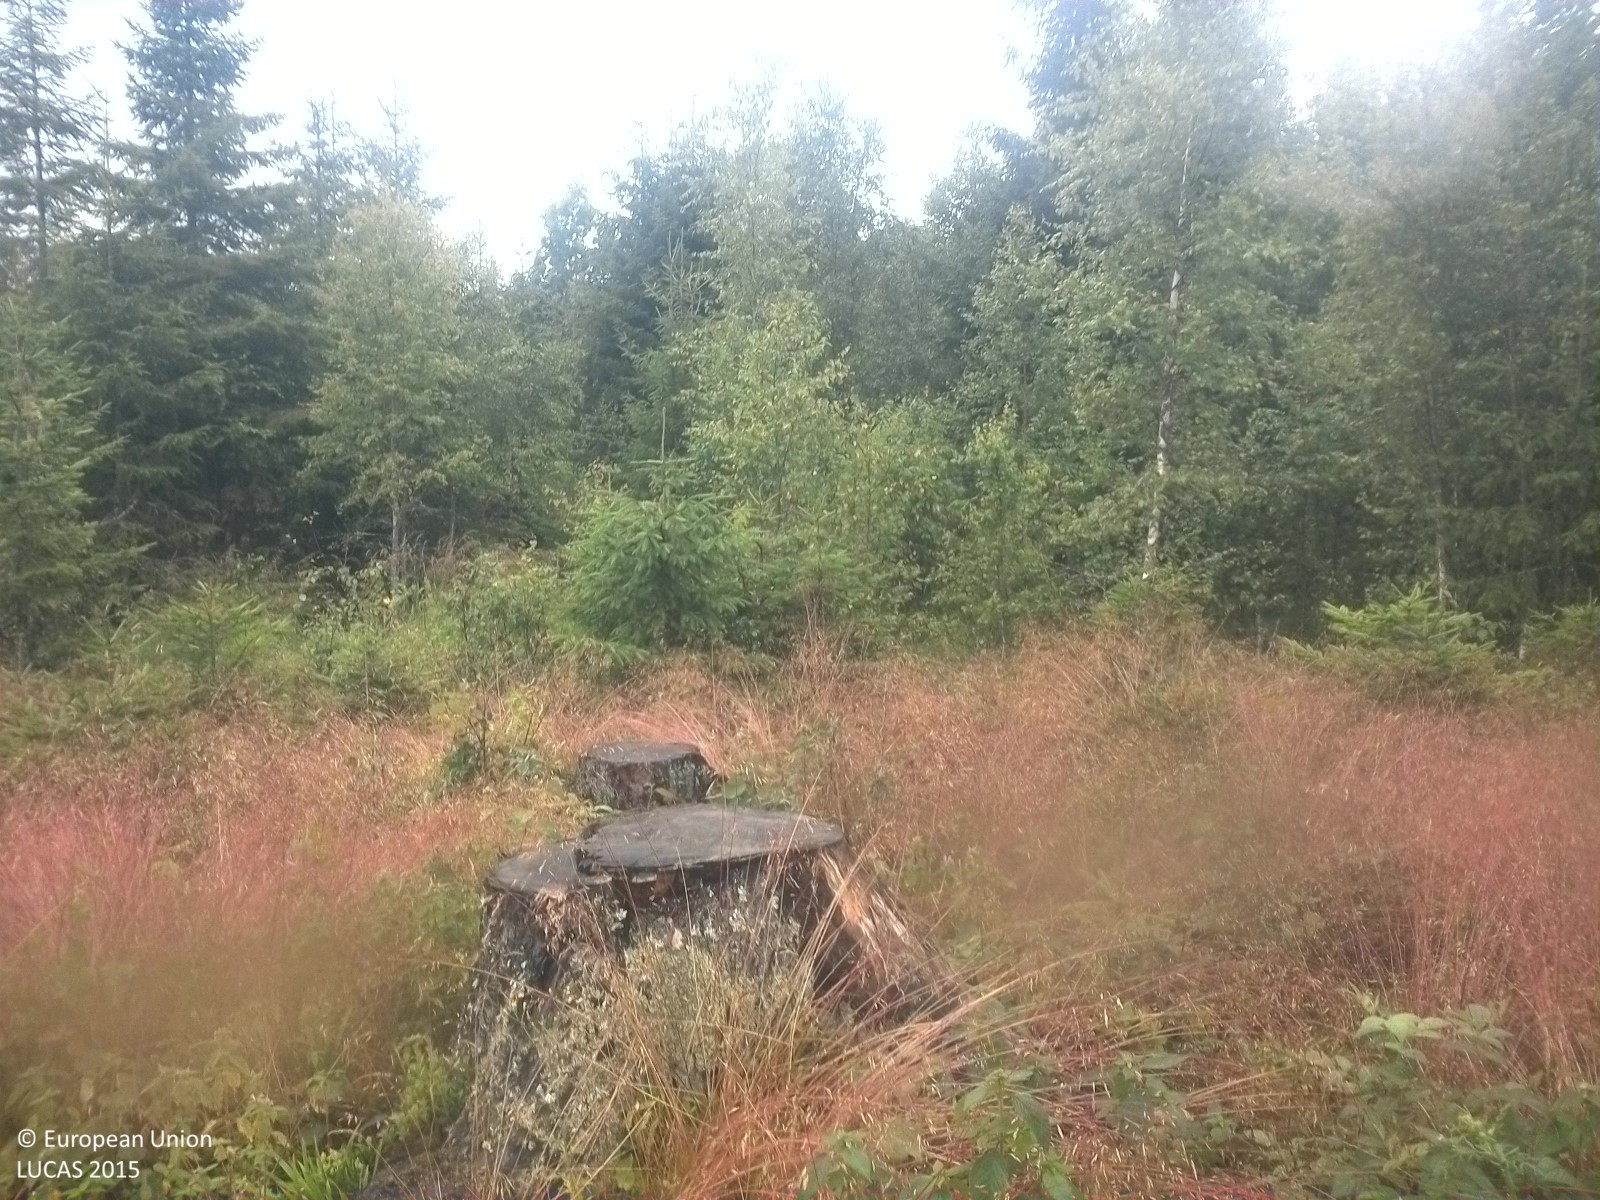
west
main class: Woodland
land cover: Spruce dominated coniferous woodland
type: boreal forest
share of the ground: 10 - 25 %
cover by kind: herbaceous plants 60 %, coniferous forest trees 20 %, shrubs 20 %
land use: Forestry
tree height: < 5 m
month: July
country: SE
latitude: 58.9973
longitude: 14.8486
